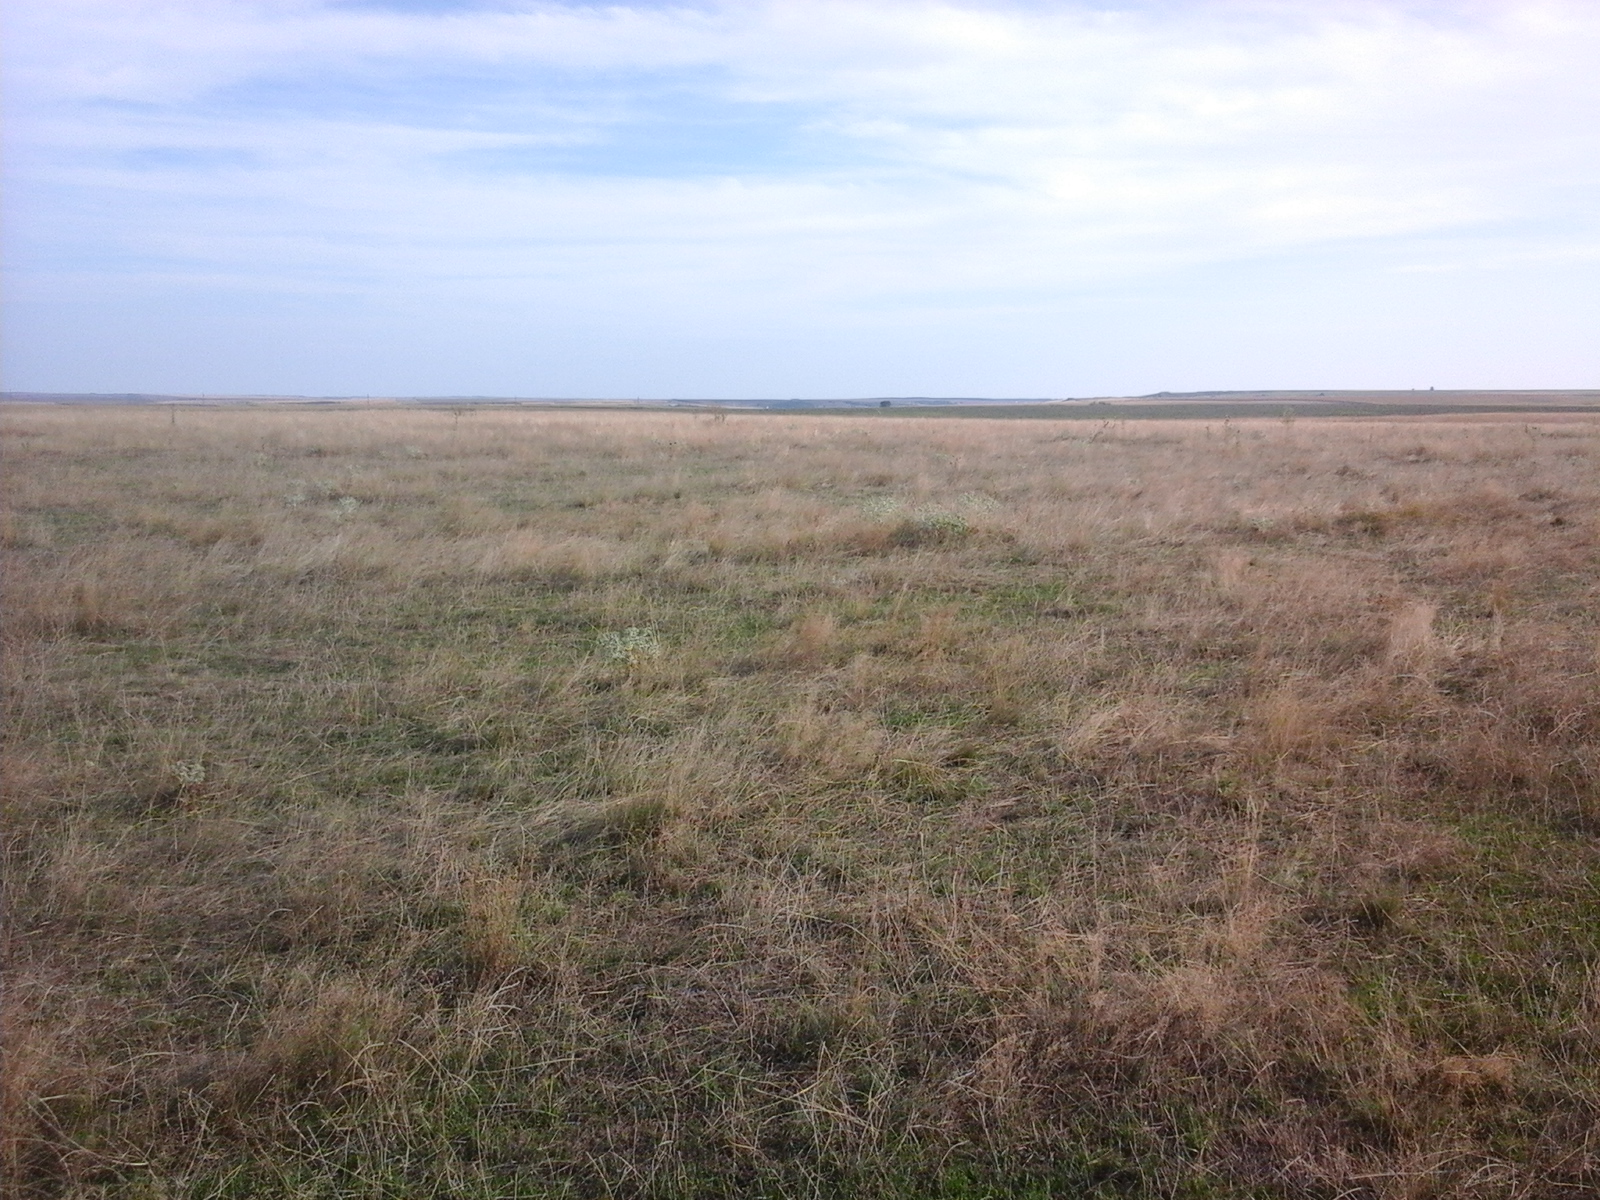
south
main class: Grassland
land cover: Grassland without tree/shrub cover
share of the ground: > 75 %
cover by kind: herbaceous plants 100 %
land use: Agriculture (excluding fallow land and kitchen gardens)
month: August
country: RO
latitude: 46.0165
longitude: 21.3611
